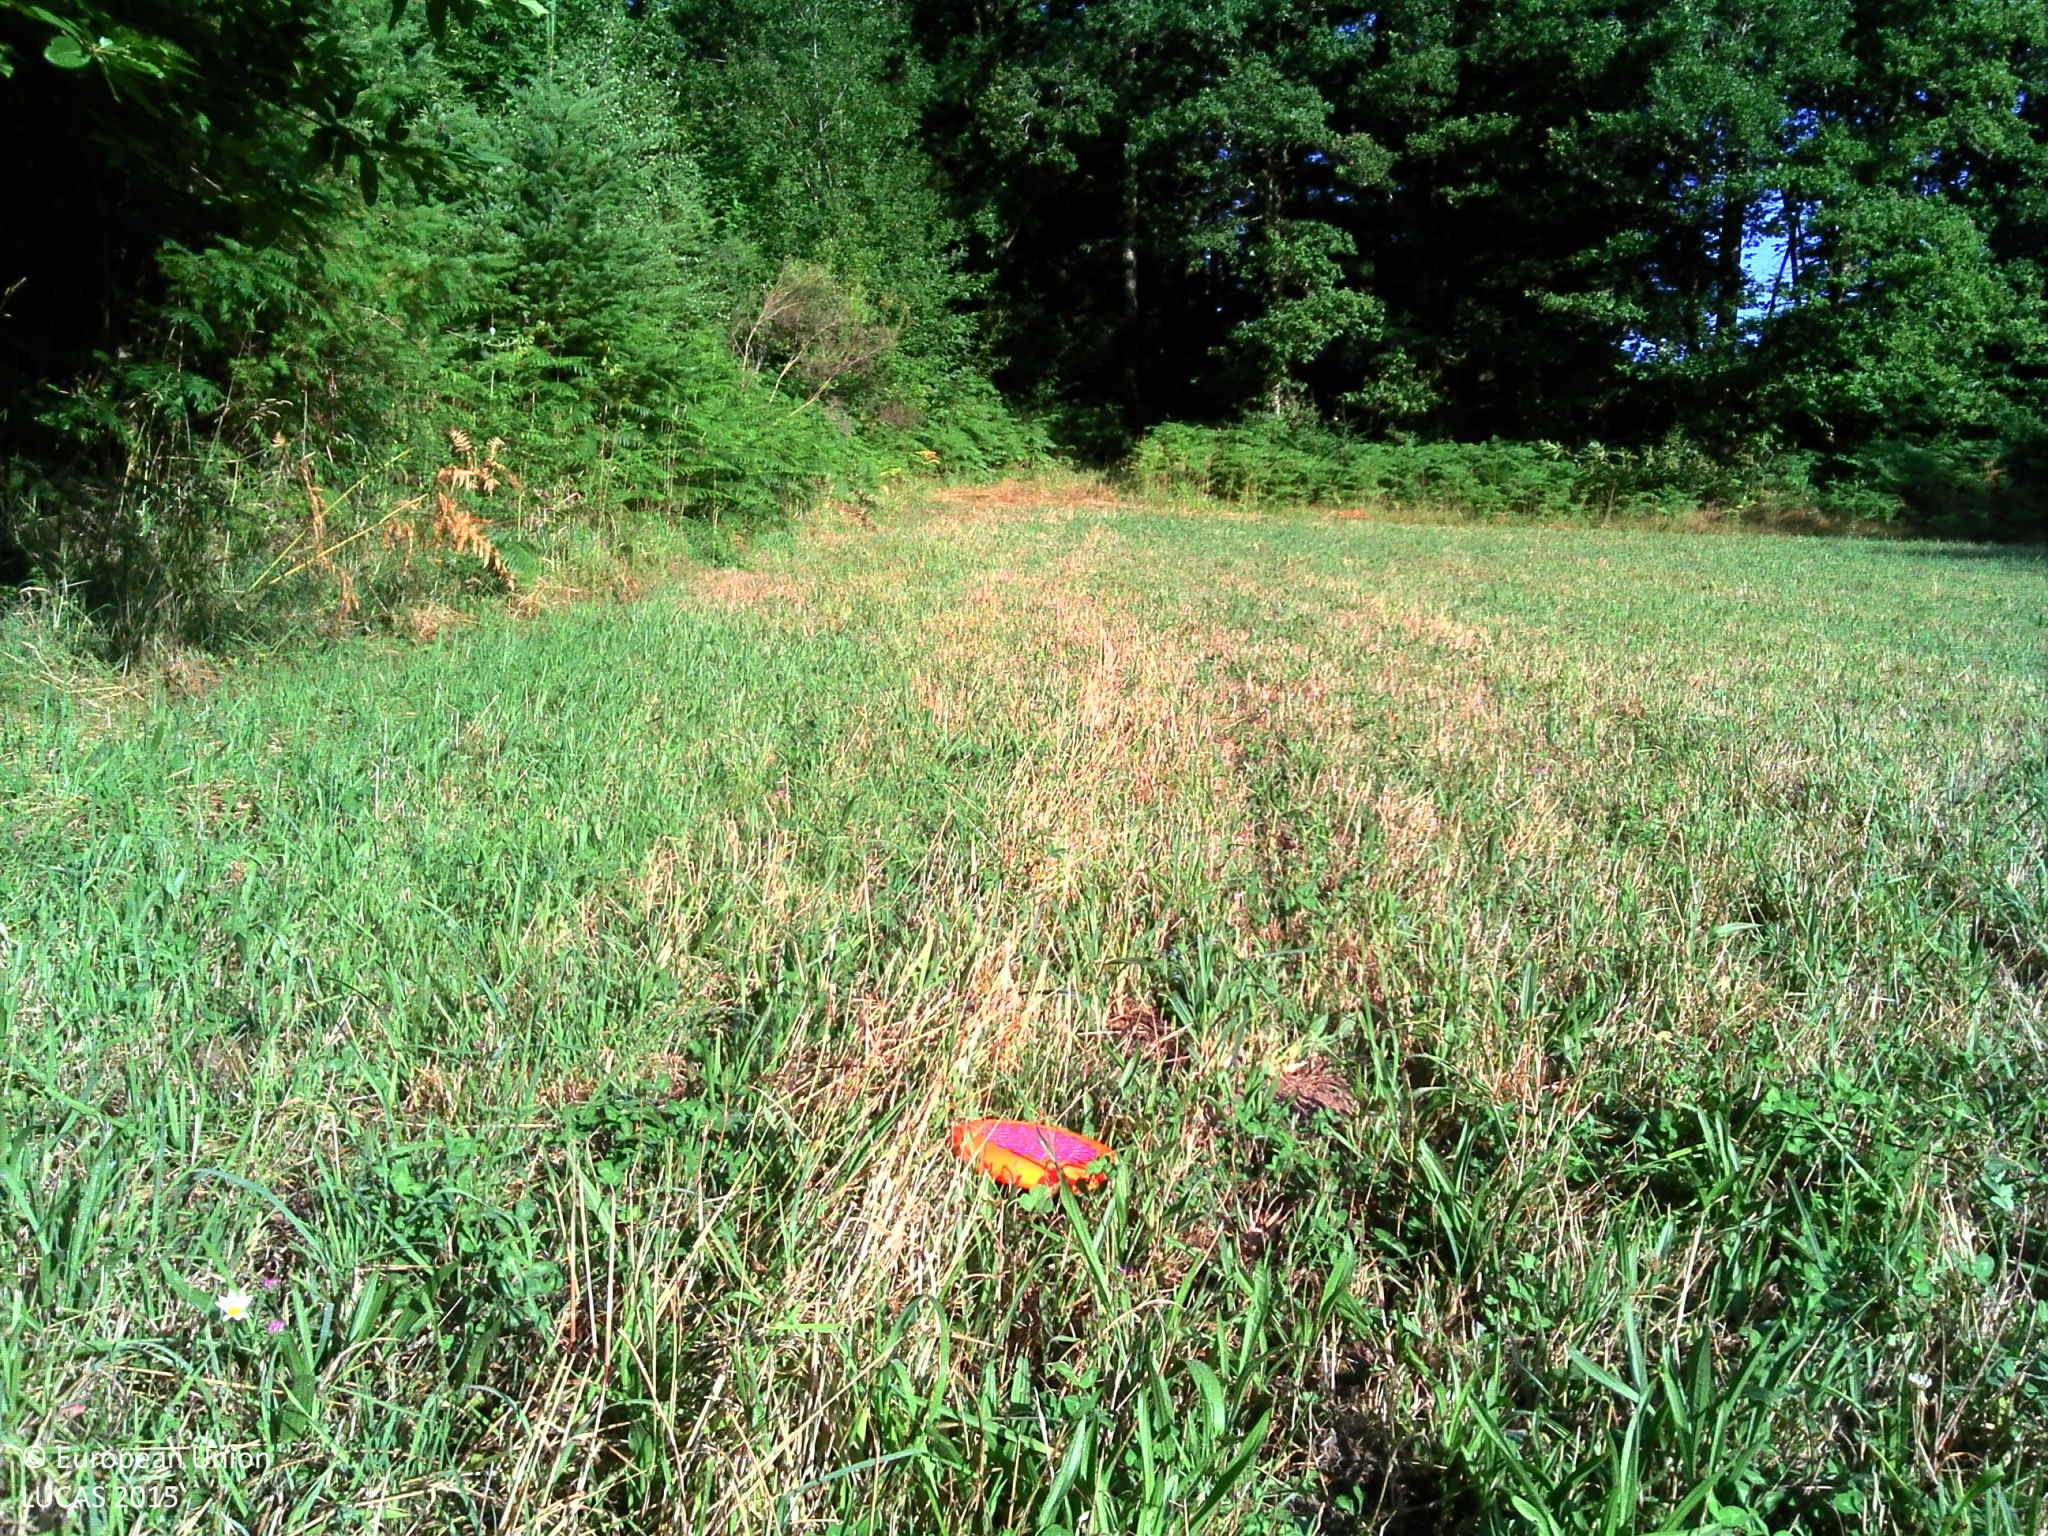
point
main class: Cropland
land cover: Temporary grasslands
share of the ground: > 75 %
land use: Agriculture (excluding fallow land and kitchen gardens)
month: July
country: FR
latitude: 45.7289
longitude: 1.8091
